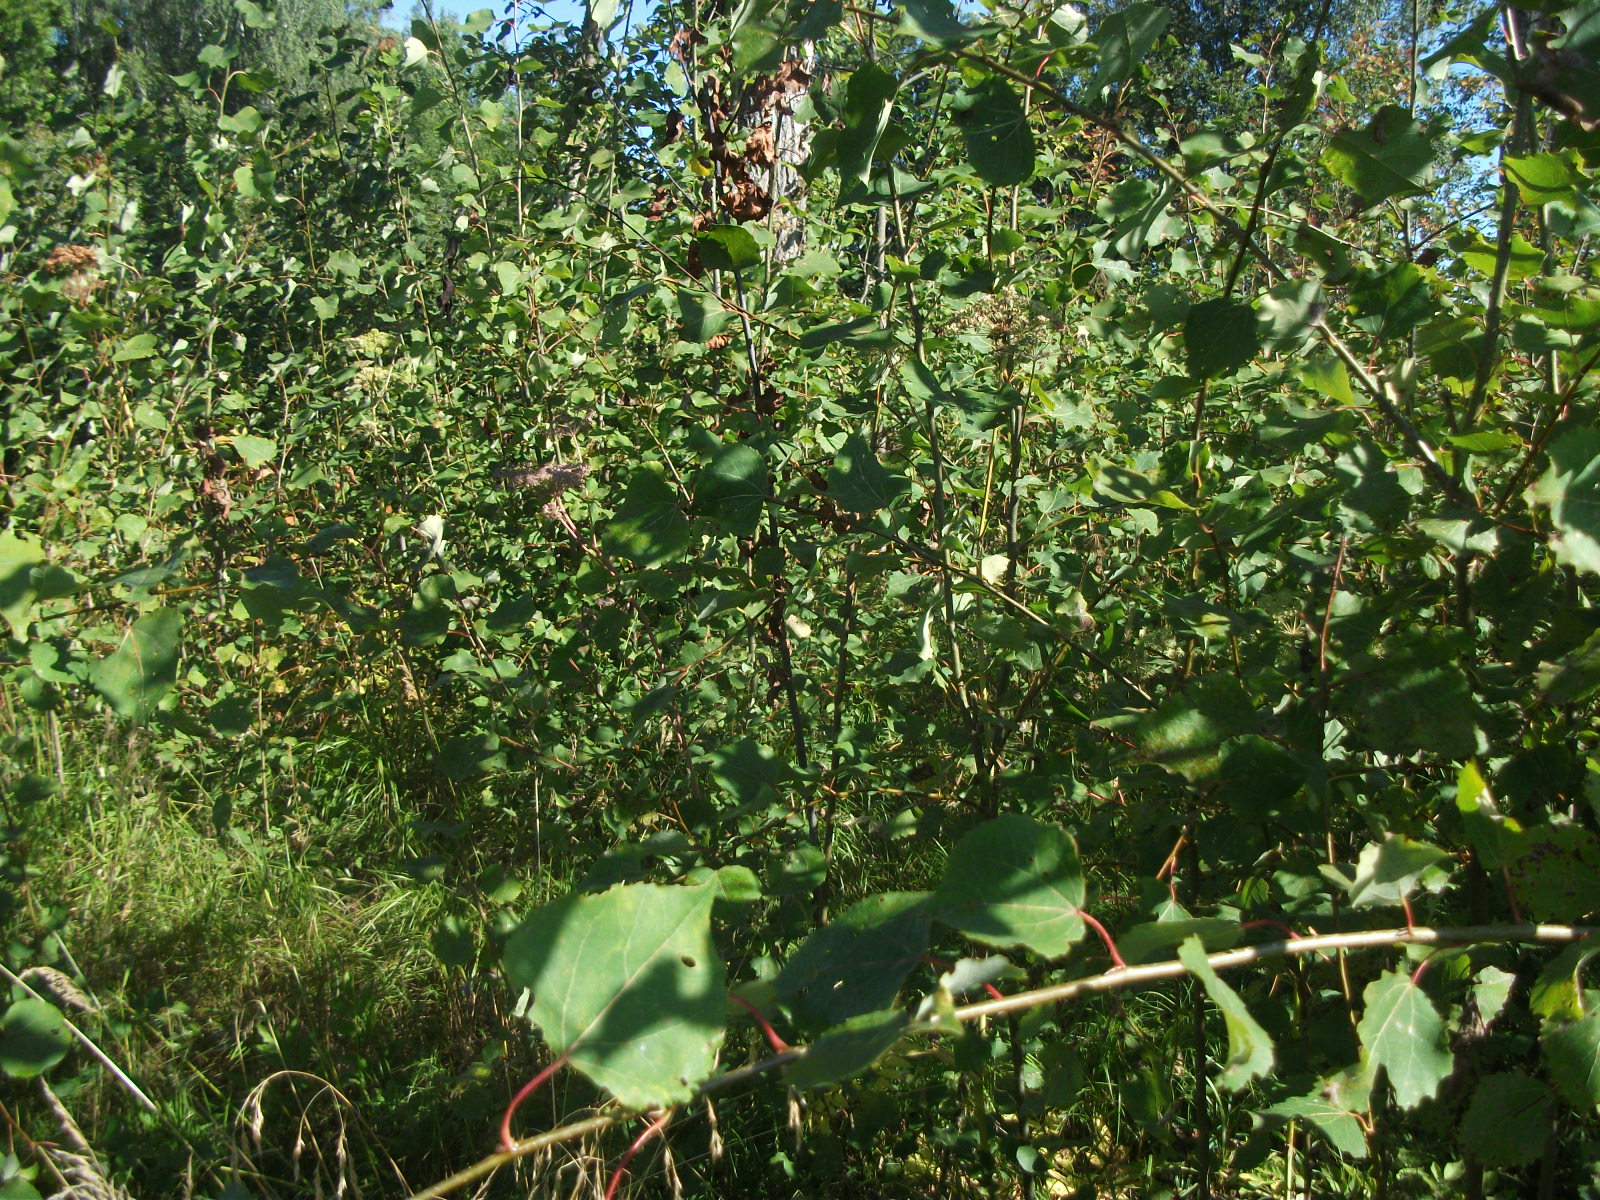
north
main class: Woodland
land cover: Broadleaved woodland
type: non-riverine alder, birch or aspen forest
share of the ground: > 75 %
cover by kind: broadleaved forest trees 80 %, shrubs 10 %, herbaceous plants 10 %
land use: Forestry
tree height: < 5 m
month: August
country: LV
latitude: 56.2874
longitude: 26.3479
